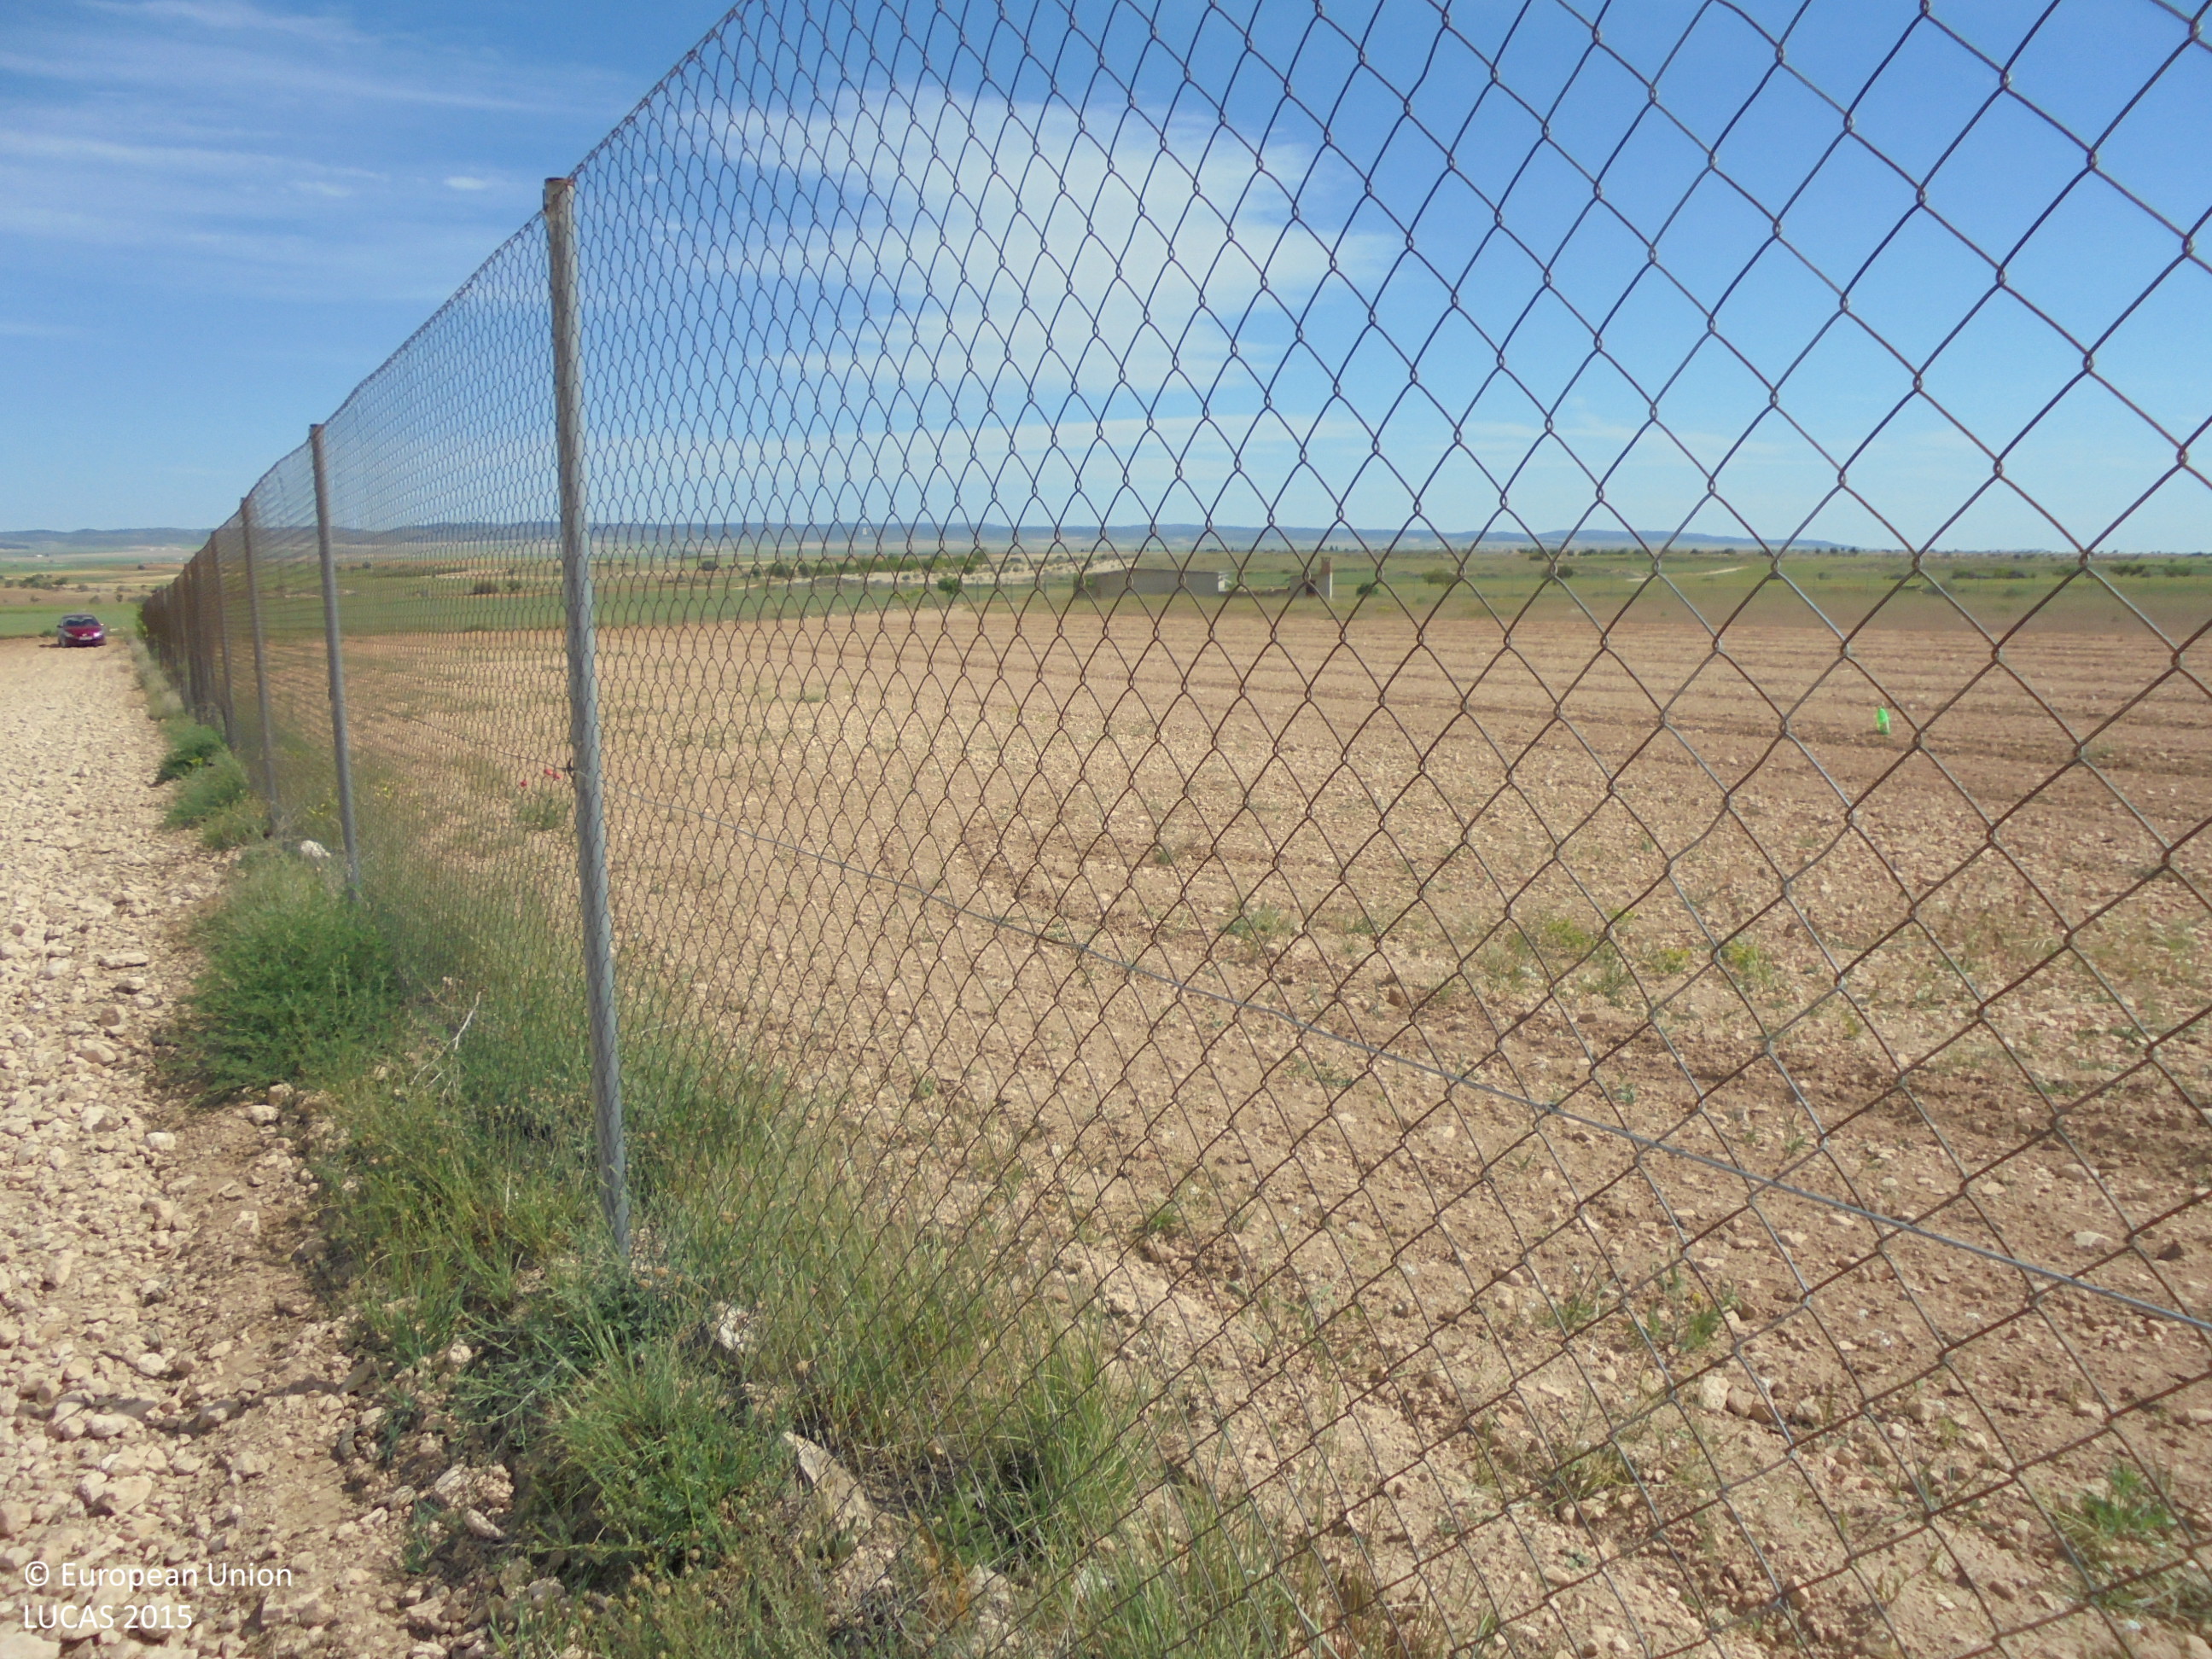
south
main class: Grassland
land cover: Spontaneously vegetated surfaces
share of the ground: 10 - 25 %
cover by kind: unconsolidated bare surface 70 %, herbaceous plants 30 %
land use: Agriculture (excluding fallow land and kitchen gardens)
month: May
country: ES
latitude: 39.1268
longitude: -1.6955
